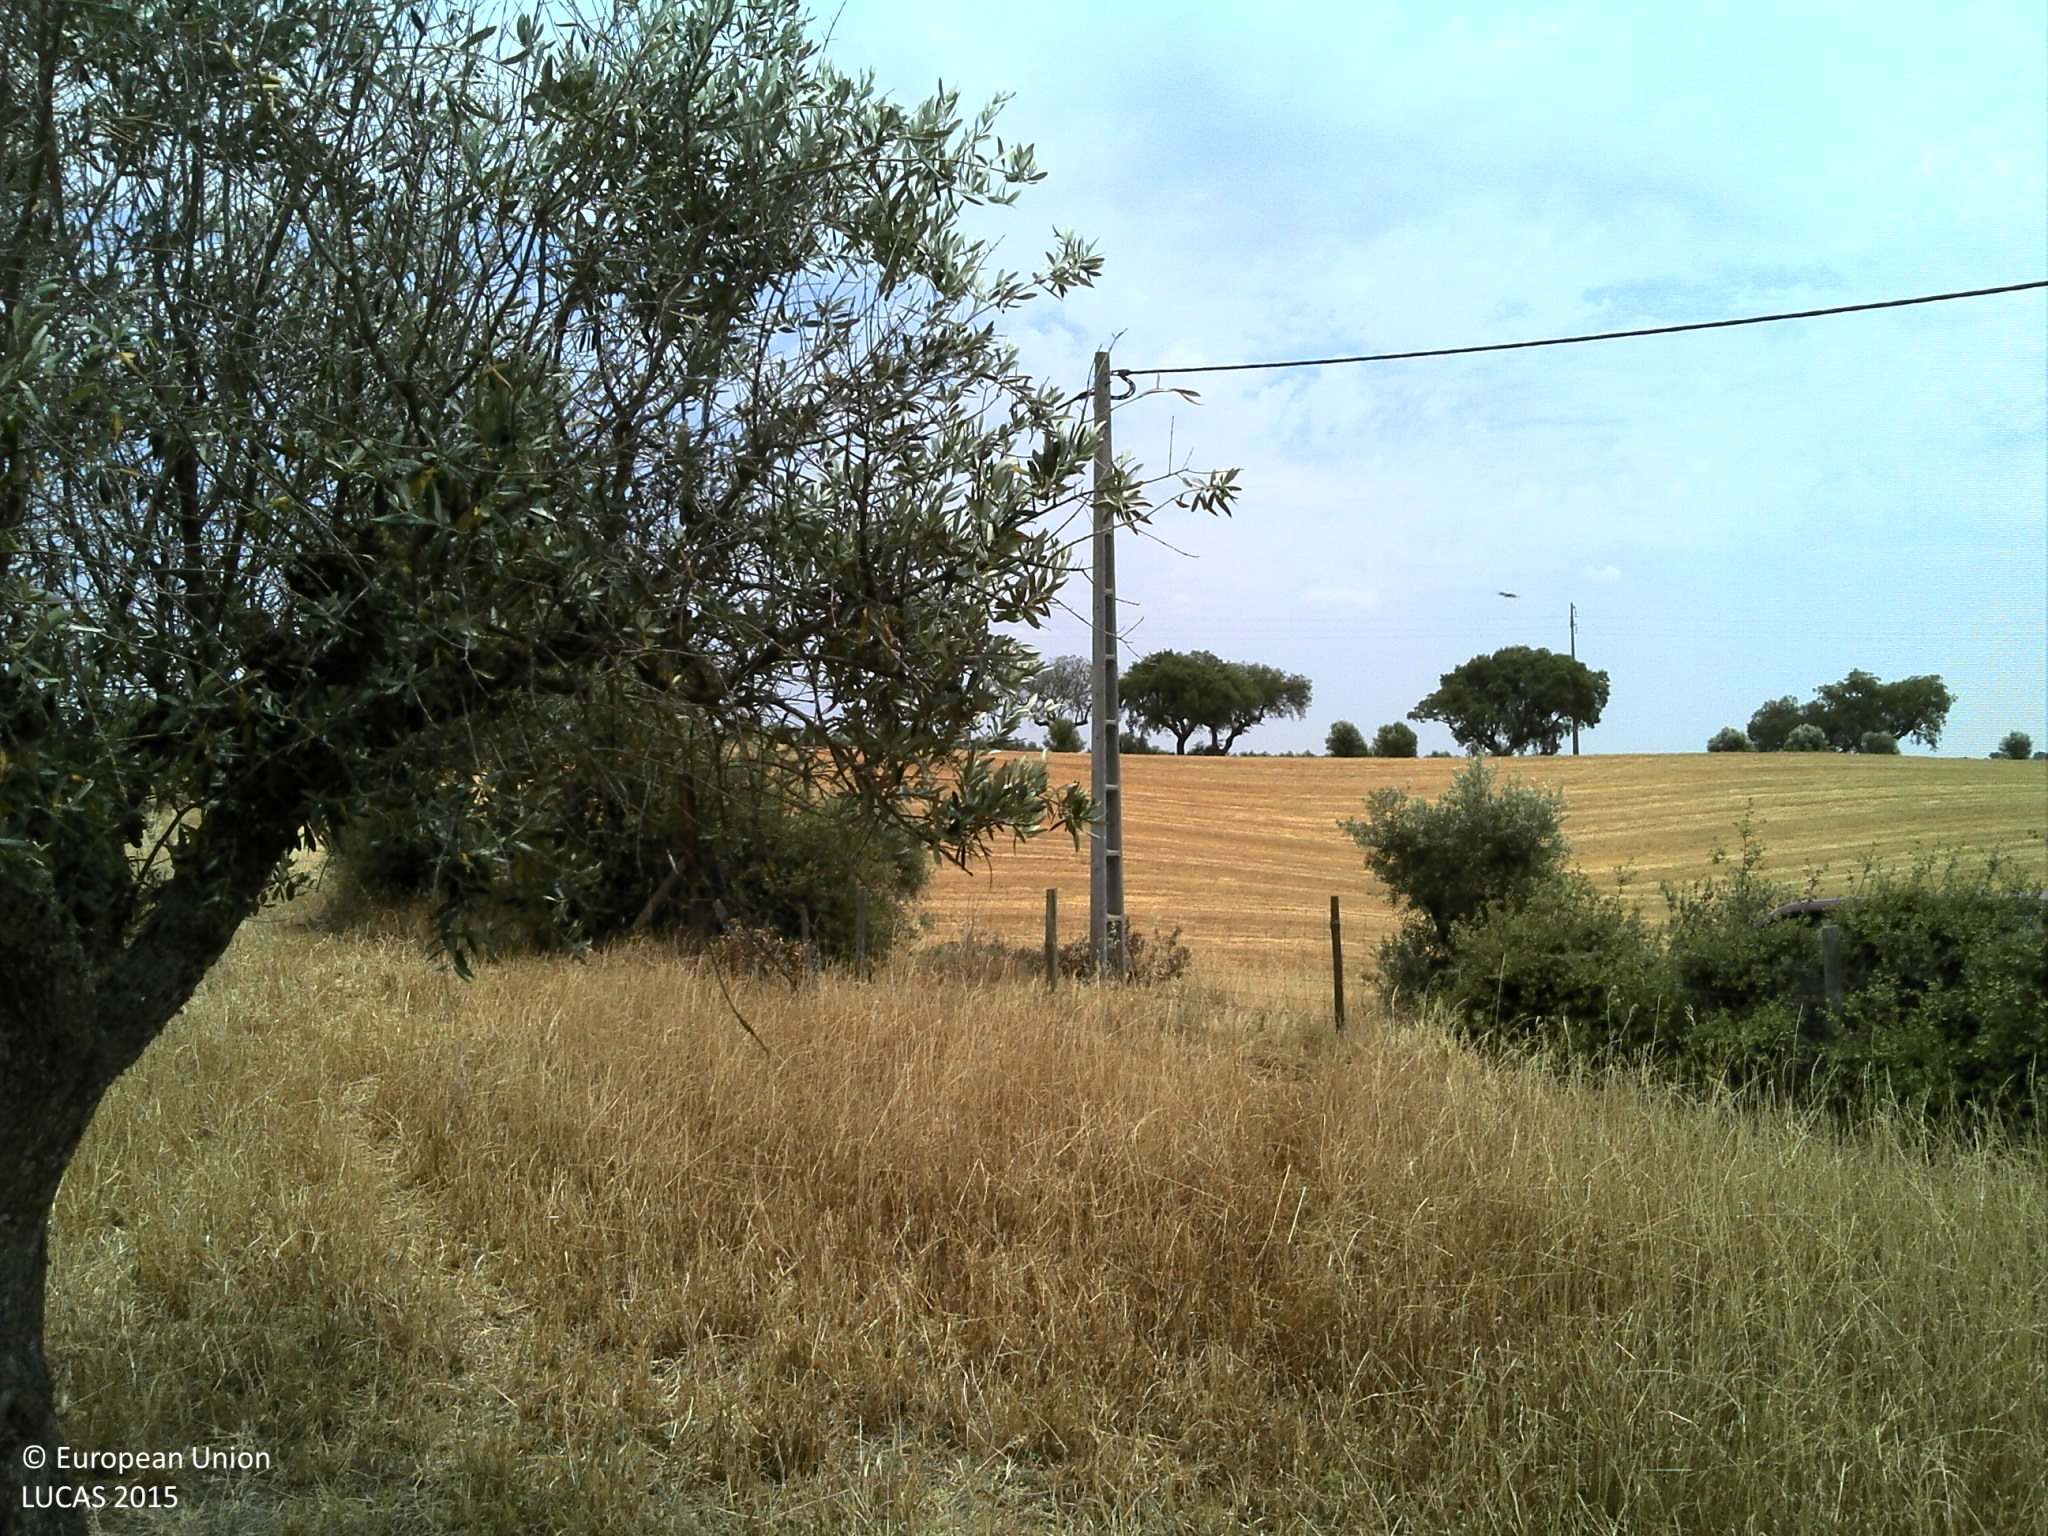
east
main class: Cropland
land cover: Olive groves
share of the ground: 10 - 25 %
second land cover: Mixed cereals for fodder
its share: 25 - 50 %
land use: Agriculture (excluding fallow land and kitchen gardens)
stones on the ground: < 10 %
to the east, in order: Olive groves; Mixed cereals for fodder; Fences; Grass margins; Tracks; Electric lines; Abandoned hedges; Oats; Tracks; Grass margins; Fences; Tracks; Olive groves
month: June
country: PT
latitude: 38.5749
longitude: -7.7702
